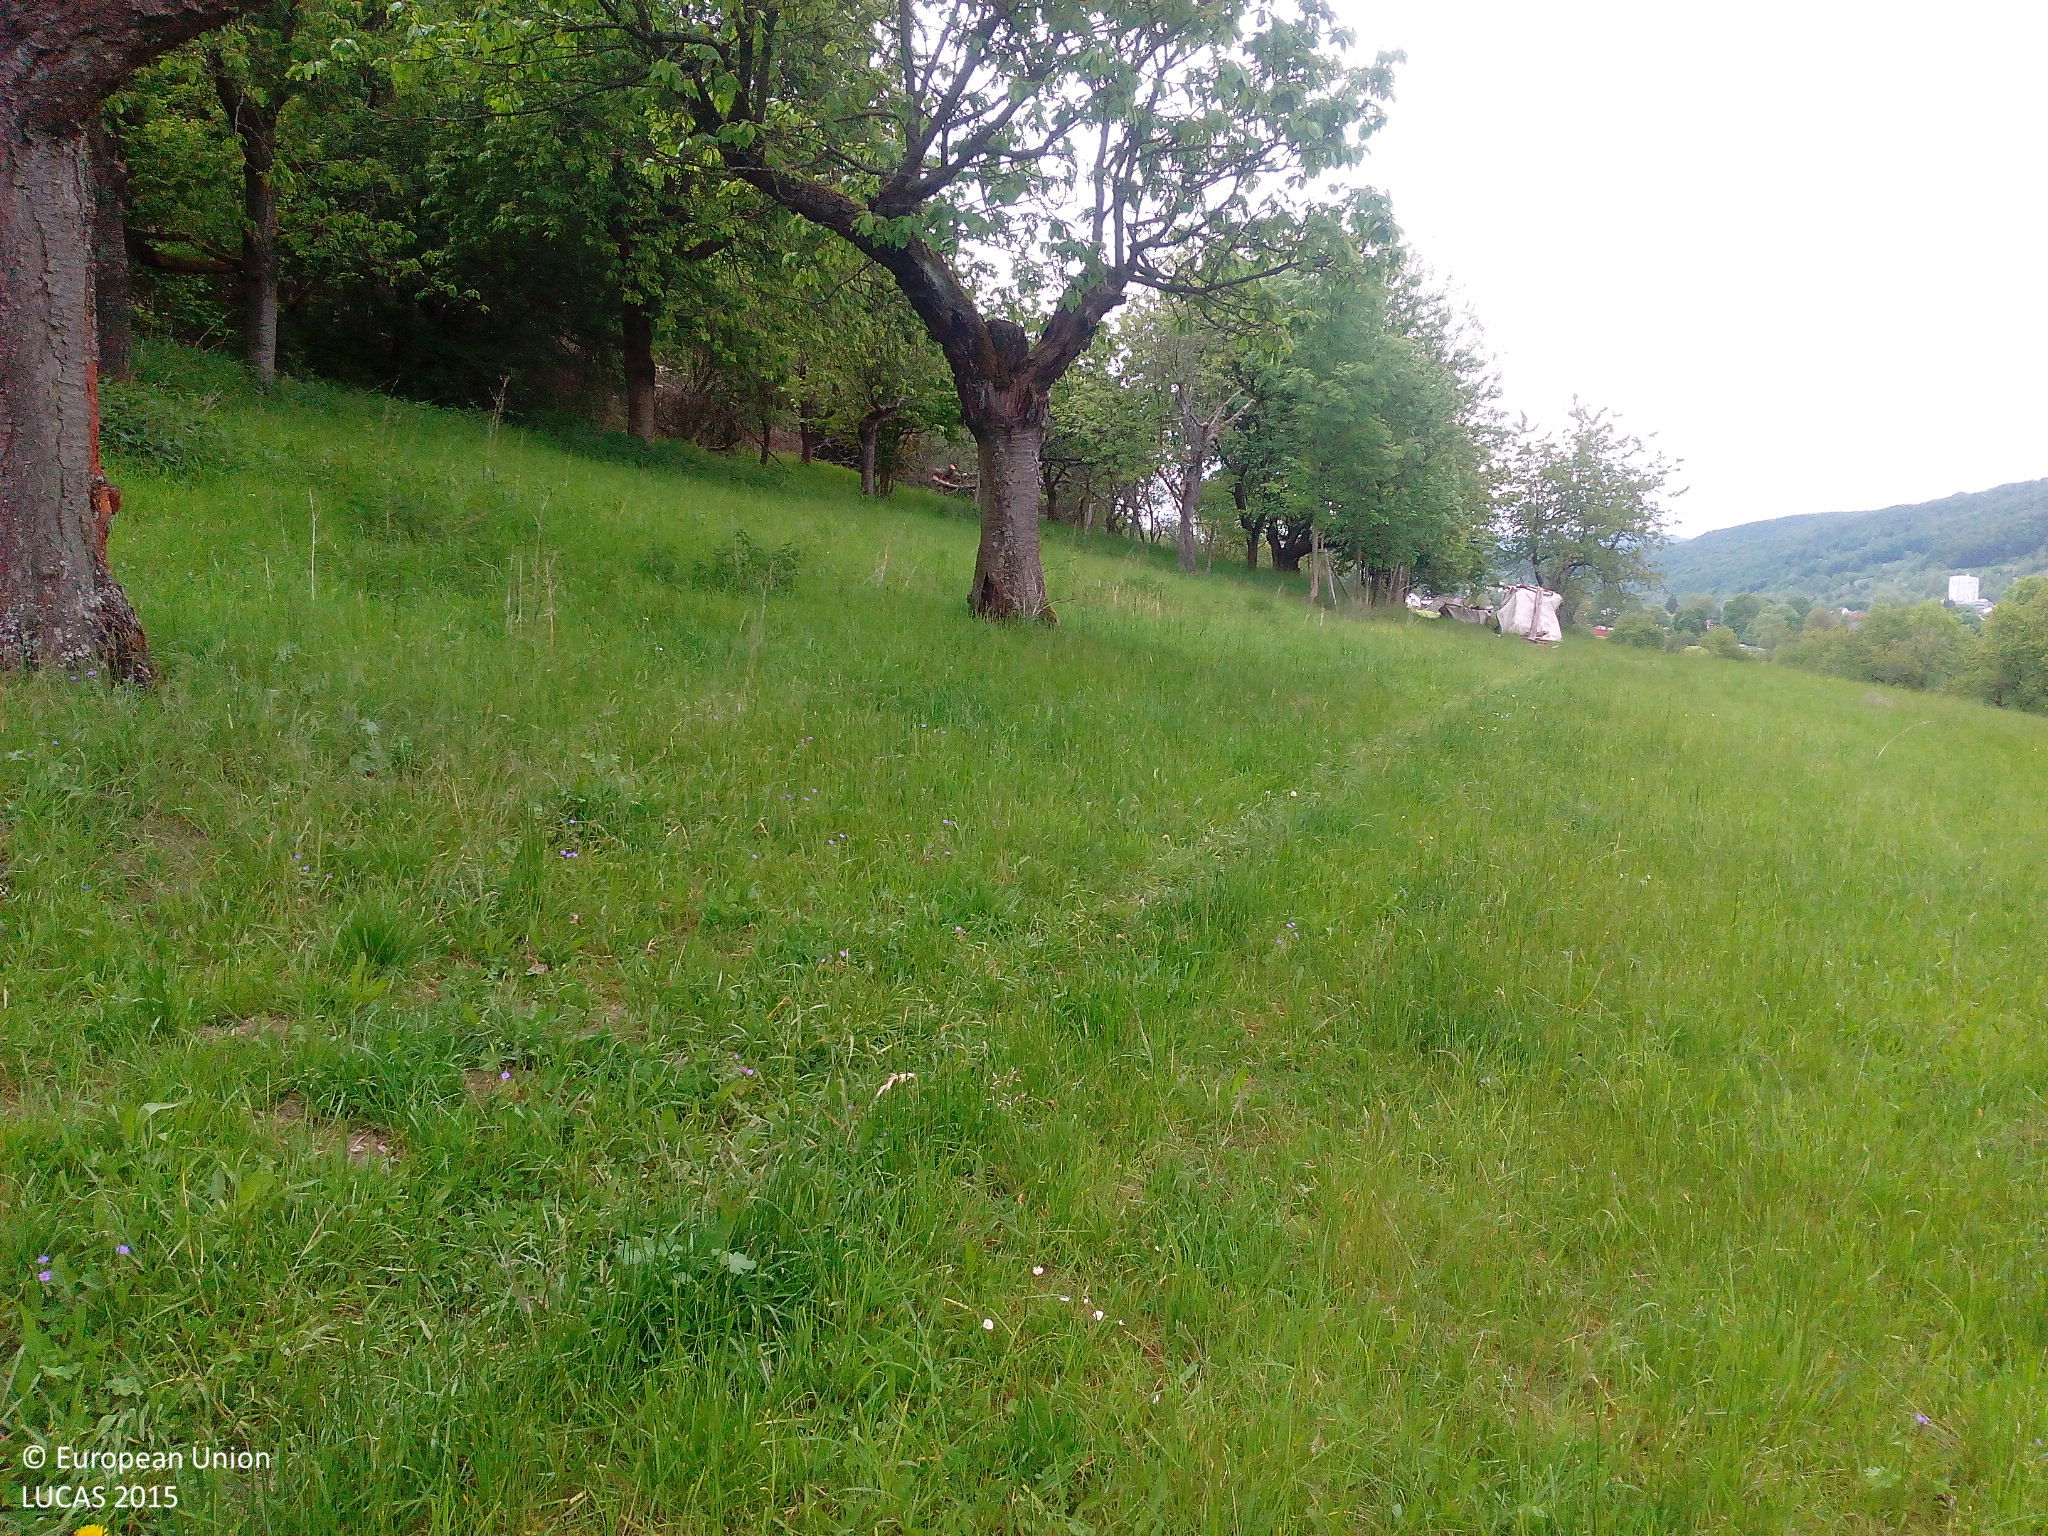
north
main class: Cropland
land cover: Cherry fruit
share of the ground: 25 - 50 %
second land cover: Grassland without tree/shrub cover
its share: > 75 %
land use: Agriculture (excluding fallow land and kitchen gardens)
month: May
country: DE
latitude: 51.2809
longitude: 9.8423
